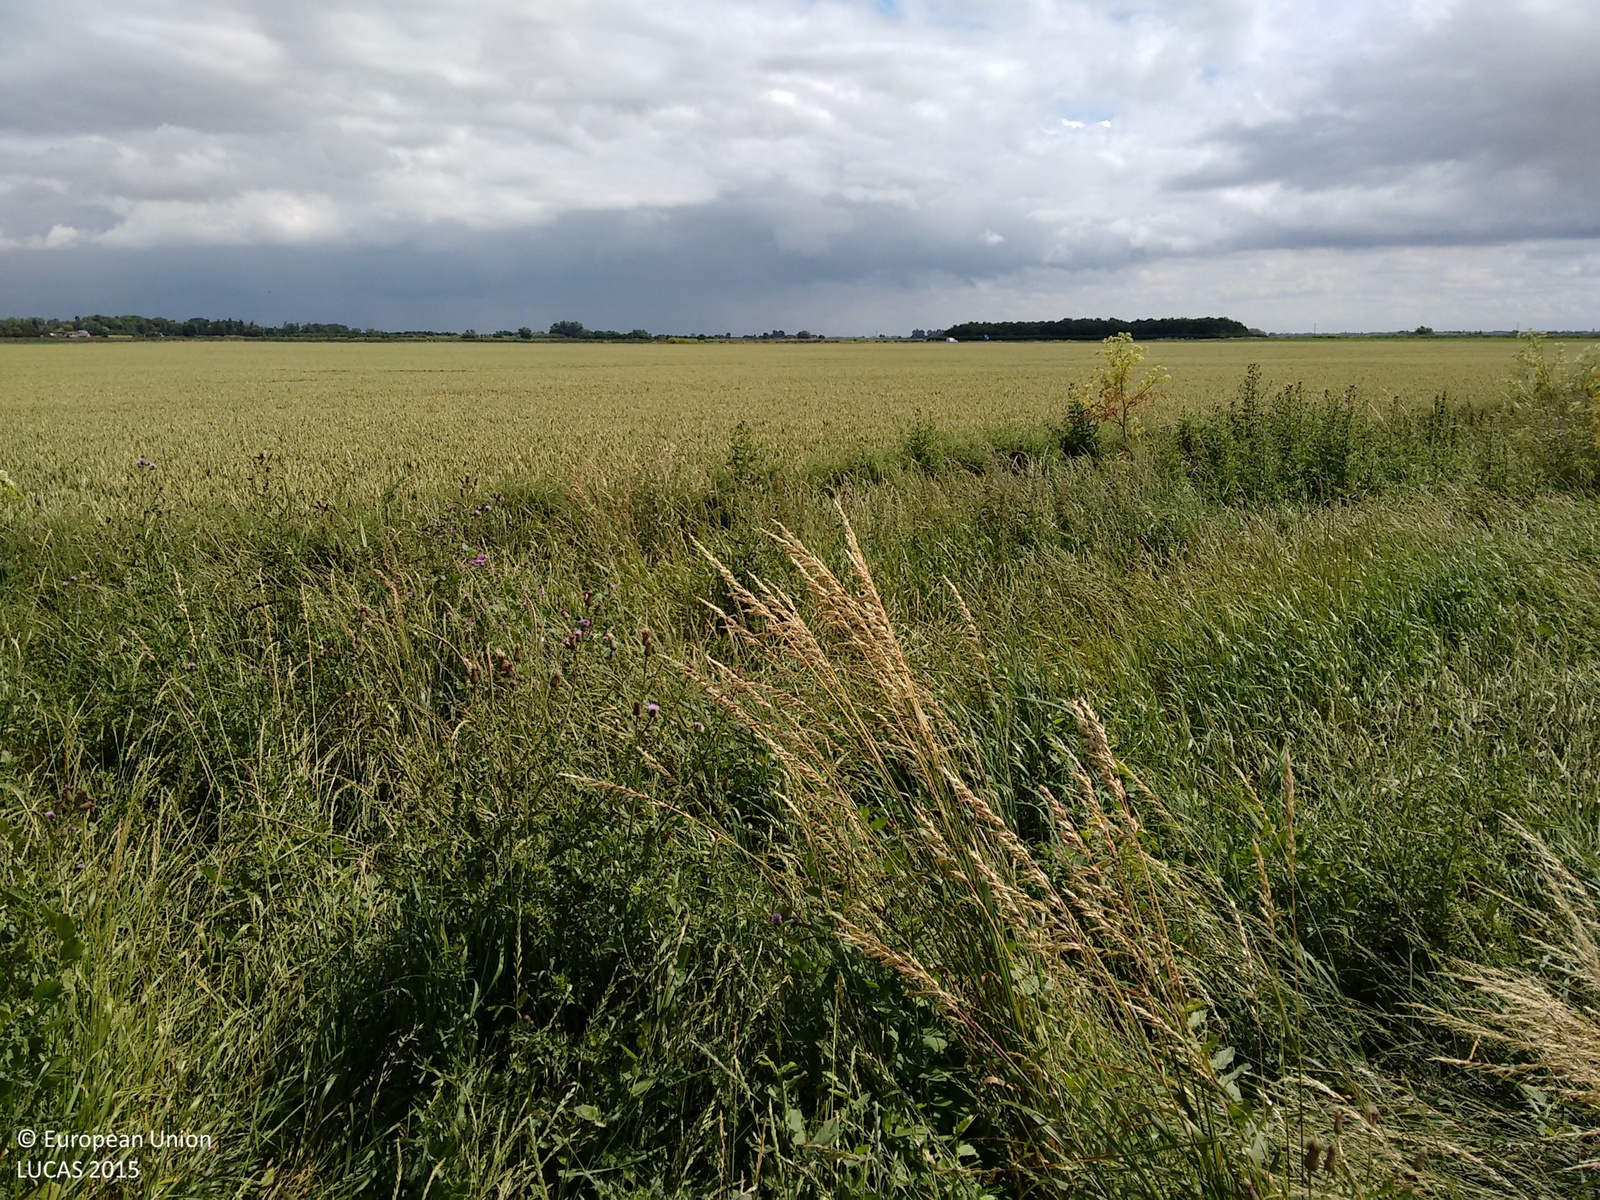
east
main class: Grassland
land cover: Grassland without tree/shrub cover
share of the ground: > 75 %
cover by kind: herbaceous plants 100 %
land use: Agriculture (excluding fallow land and kitchen gardens)
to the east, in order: Grassland without tree/shrub cover; Common wheat
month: July
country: GB
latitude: 52.4263
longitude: 0.0115
